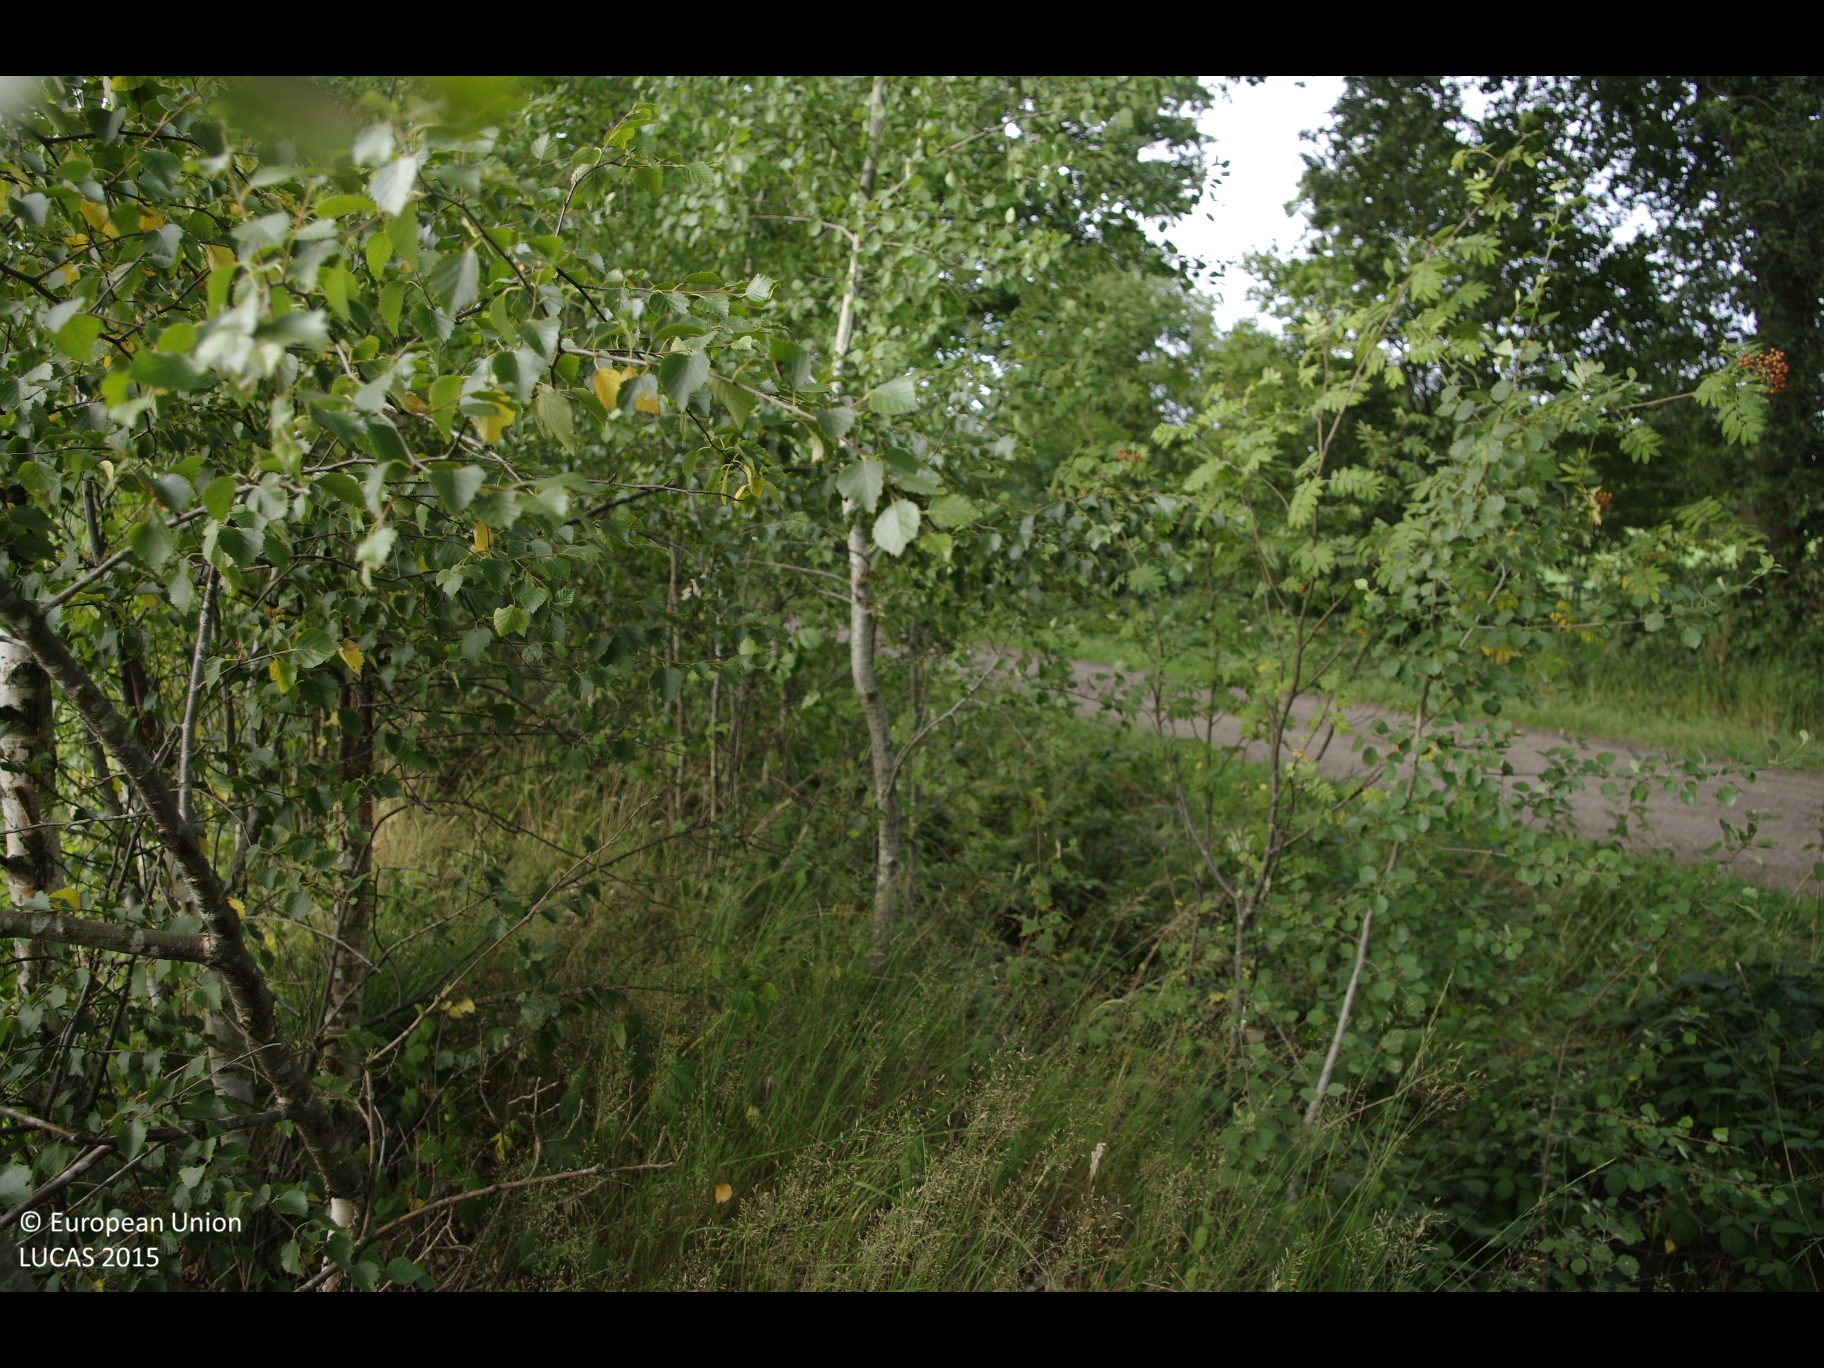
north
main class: Cropland
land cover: Maize
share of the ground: > 75 %
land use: Agriculture (excluding fallow land and kitchen gardens)
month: July
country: DE
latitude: 53.9770
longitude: 9.8933
